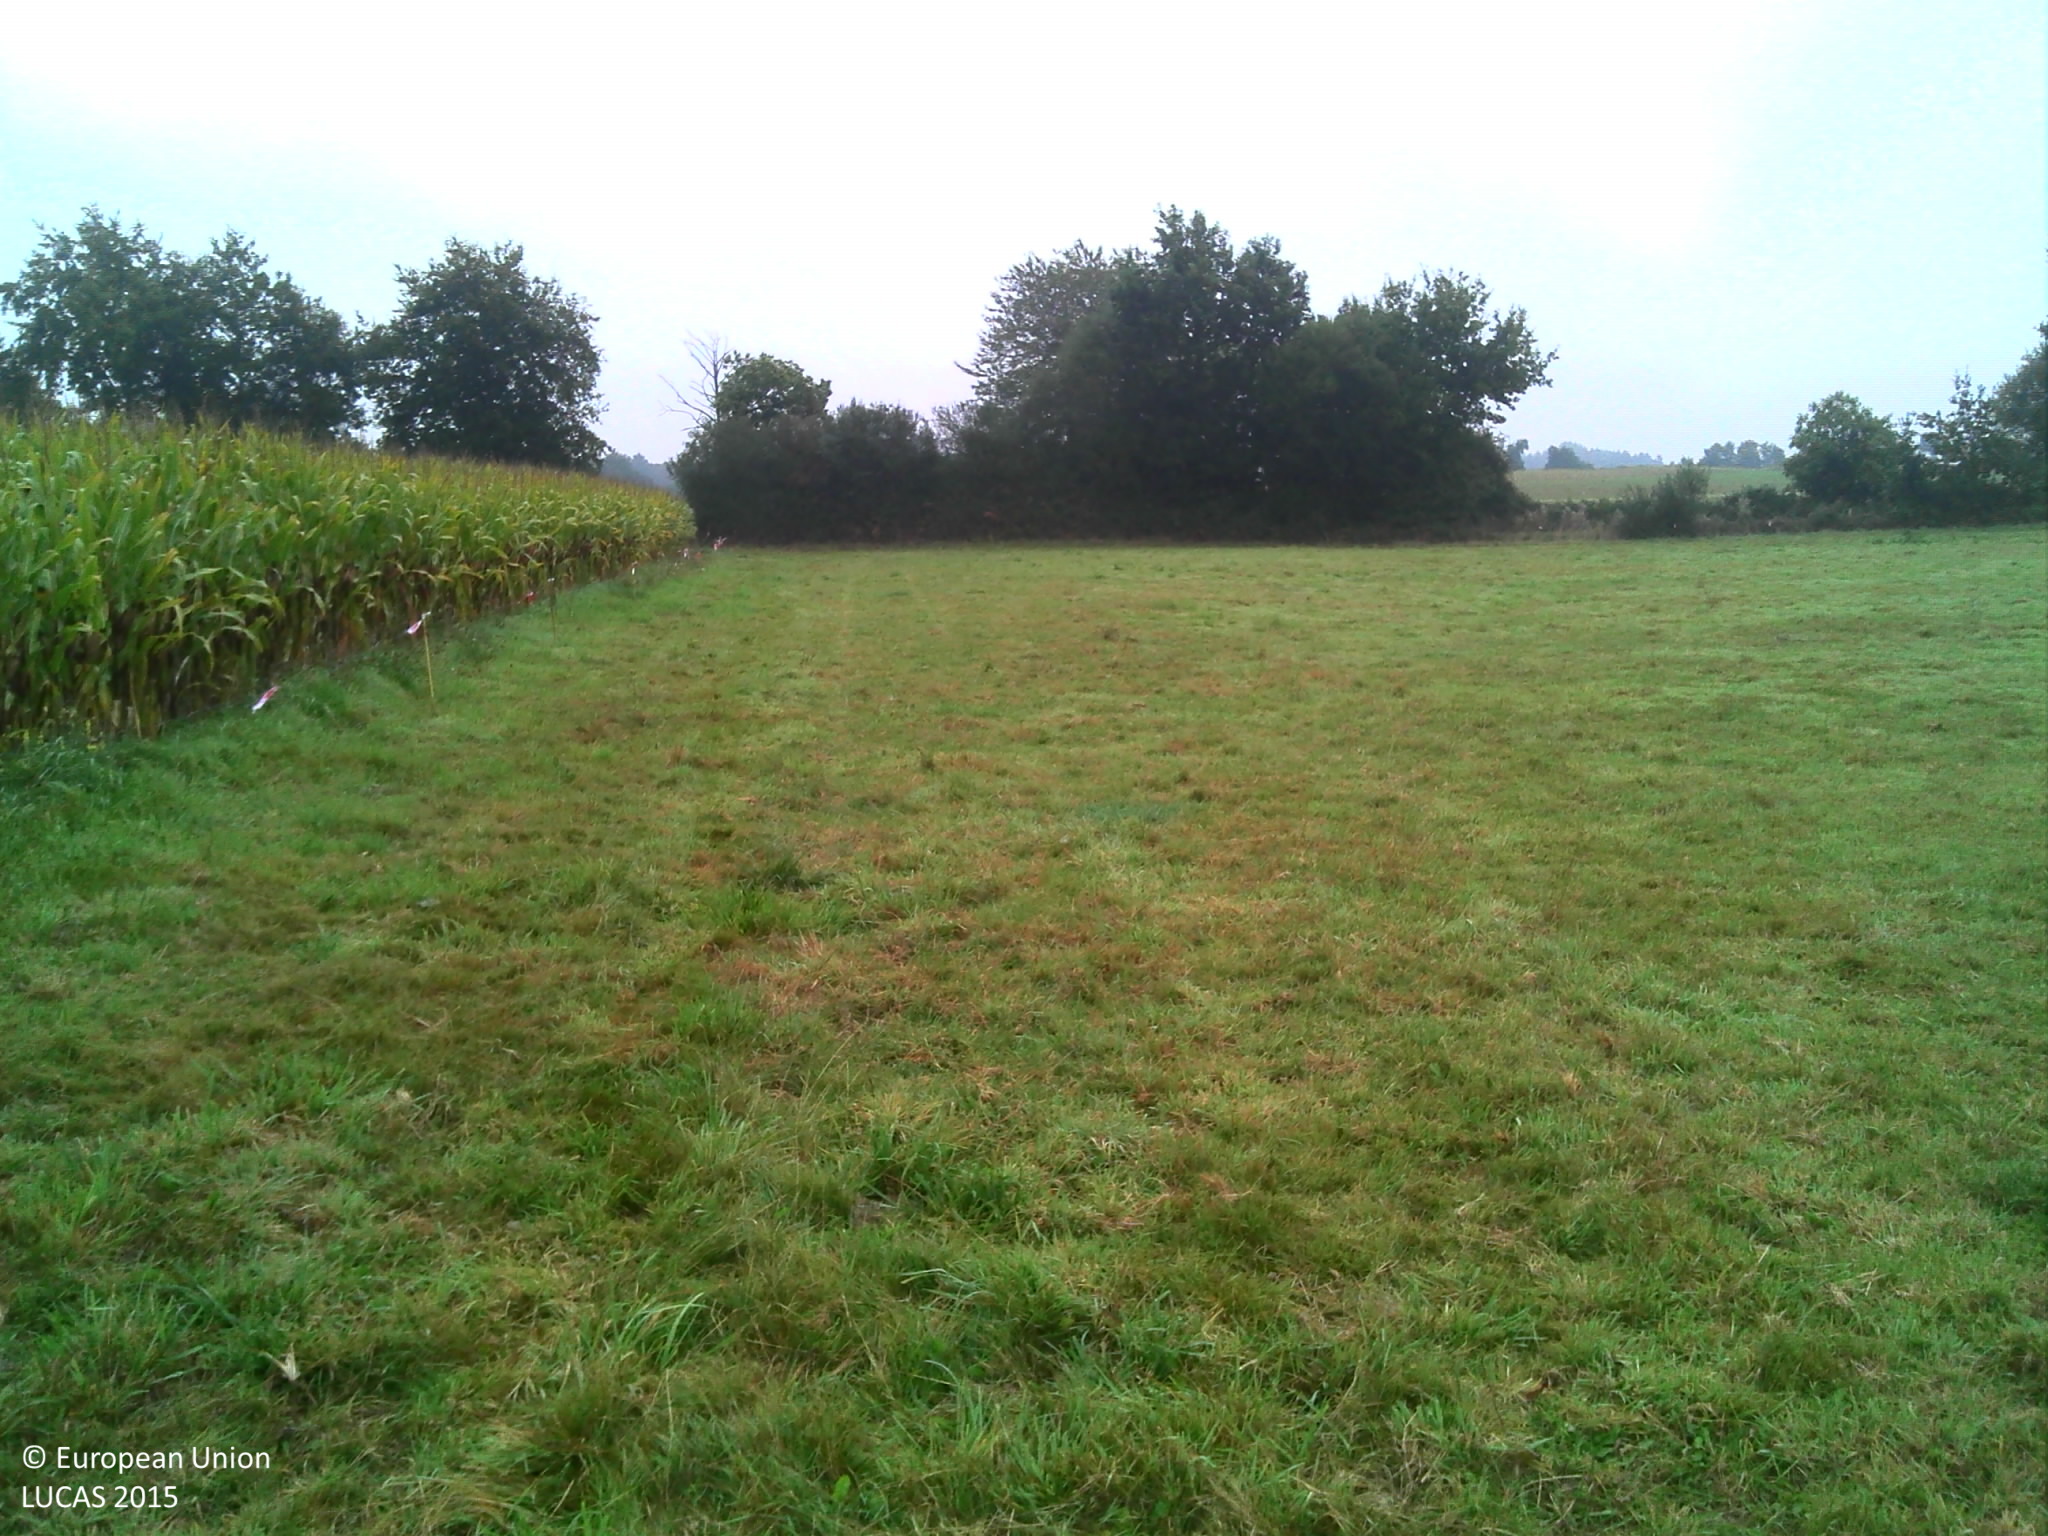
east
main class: Grassland
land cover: Grassland without tree/shrub cover
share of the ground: > 75 %
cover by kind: herbaceous plants 100 %
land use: Agriculture (excluding fallow land and kitchen gardens)
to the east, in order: Grassland without tree/shrub cover; Fences; Managed hedges; Ditches and canals; Grass margins; Paved roads, cycling and walking lanes; Grass margins; Ditches and canals; Lines of trees; Fences; Temporary grasslands; Fences; Temporary grasslands
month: October
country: FR
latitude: 47.9434
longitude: -2.3607
